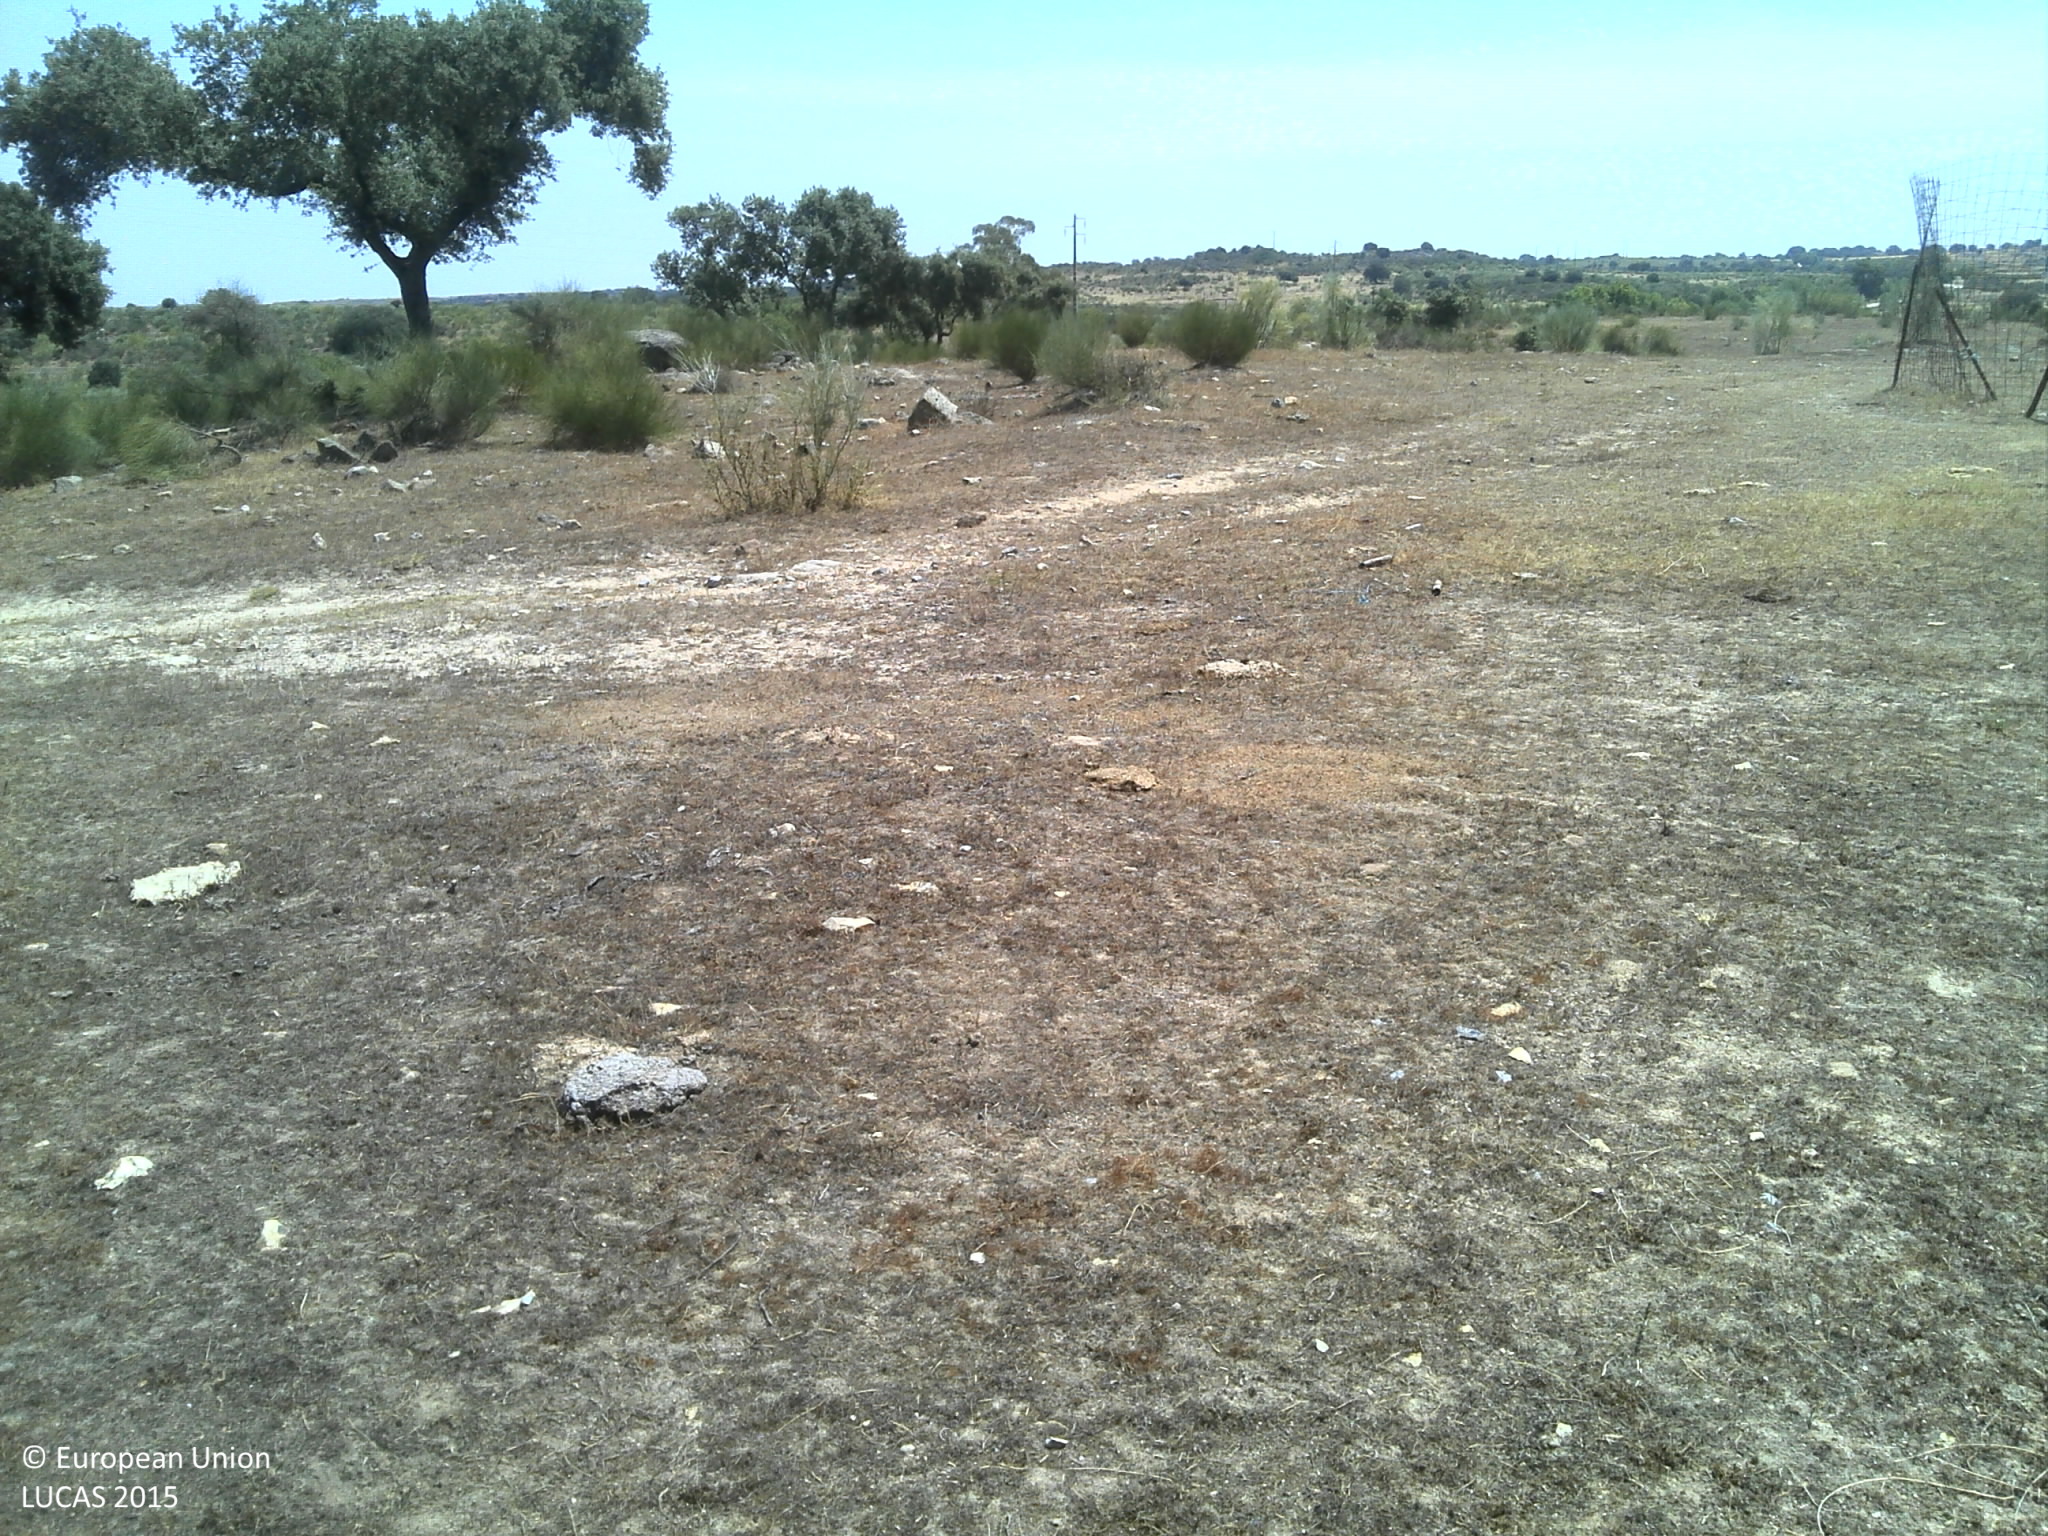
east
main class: Grassland
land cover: Grassland without tree/shrub cover
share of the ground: 10 - 25 %
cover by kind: unconsolidated bare surface 70 %, herbaceous plants 25 %
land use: Agriculture (excluding fallow land and kitchen gardens)
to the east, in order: Grassland without tree/shrub cover; Tracks; Grassland without tree/shrub cover; Grassland with sparse tree/shrub cover; Grassland without tree/shrub cover; Shrubland without tree cover; Grassland without tree/shrub cover
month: June
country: PT
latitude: 39.8387
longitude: -7.1166
